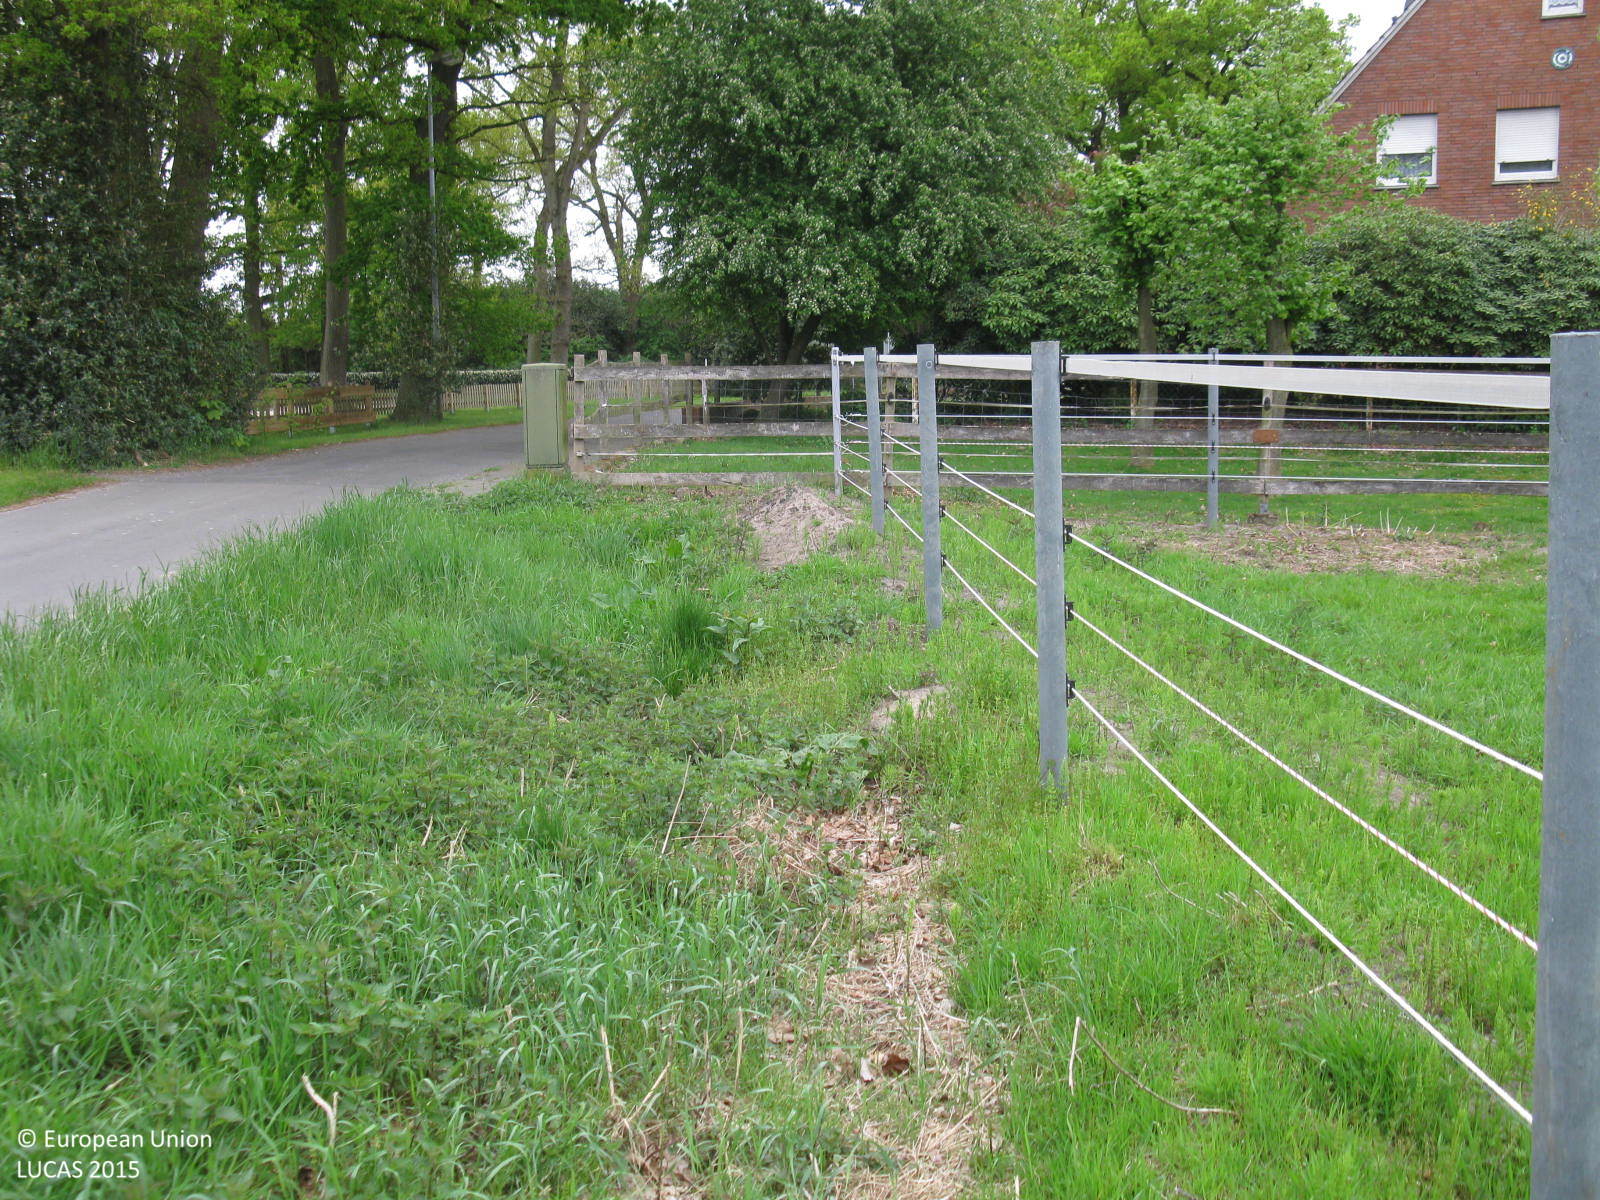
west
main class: Grassland
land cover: Grassland without tree/shrub cover
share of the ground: > 75 %
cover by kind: herbaceous plants 100 %
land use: Agriculture (excluding fallow land and kitchen gardens)
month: May
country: DE
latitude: 52.8872
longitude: 7.3402
